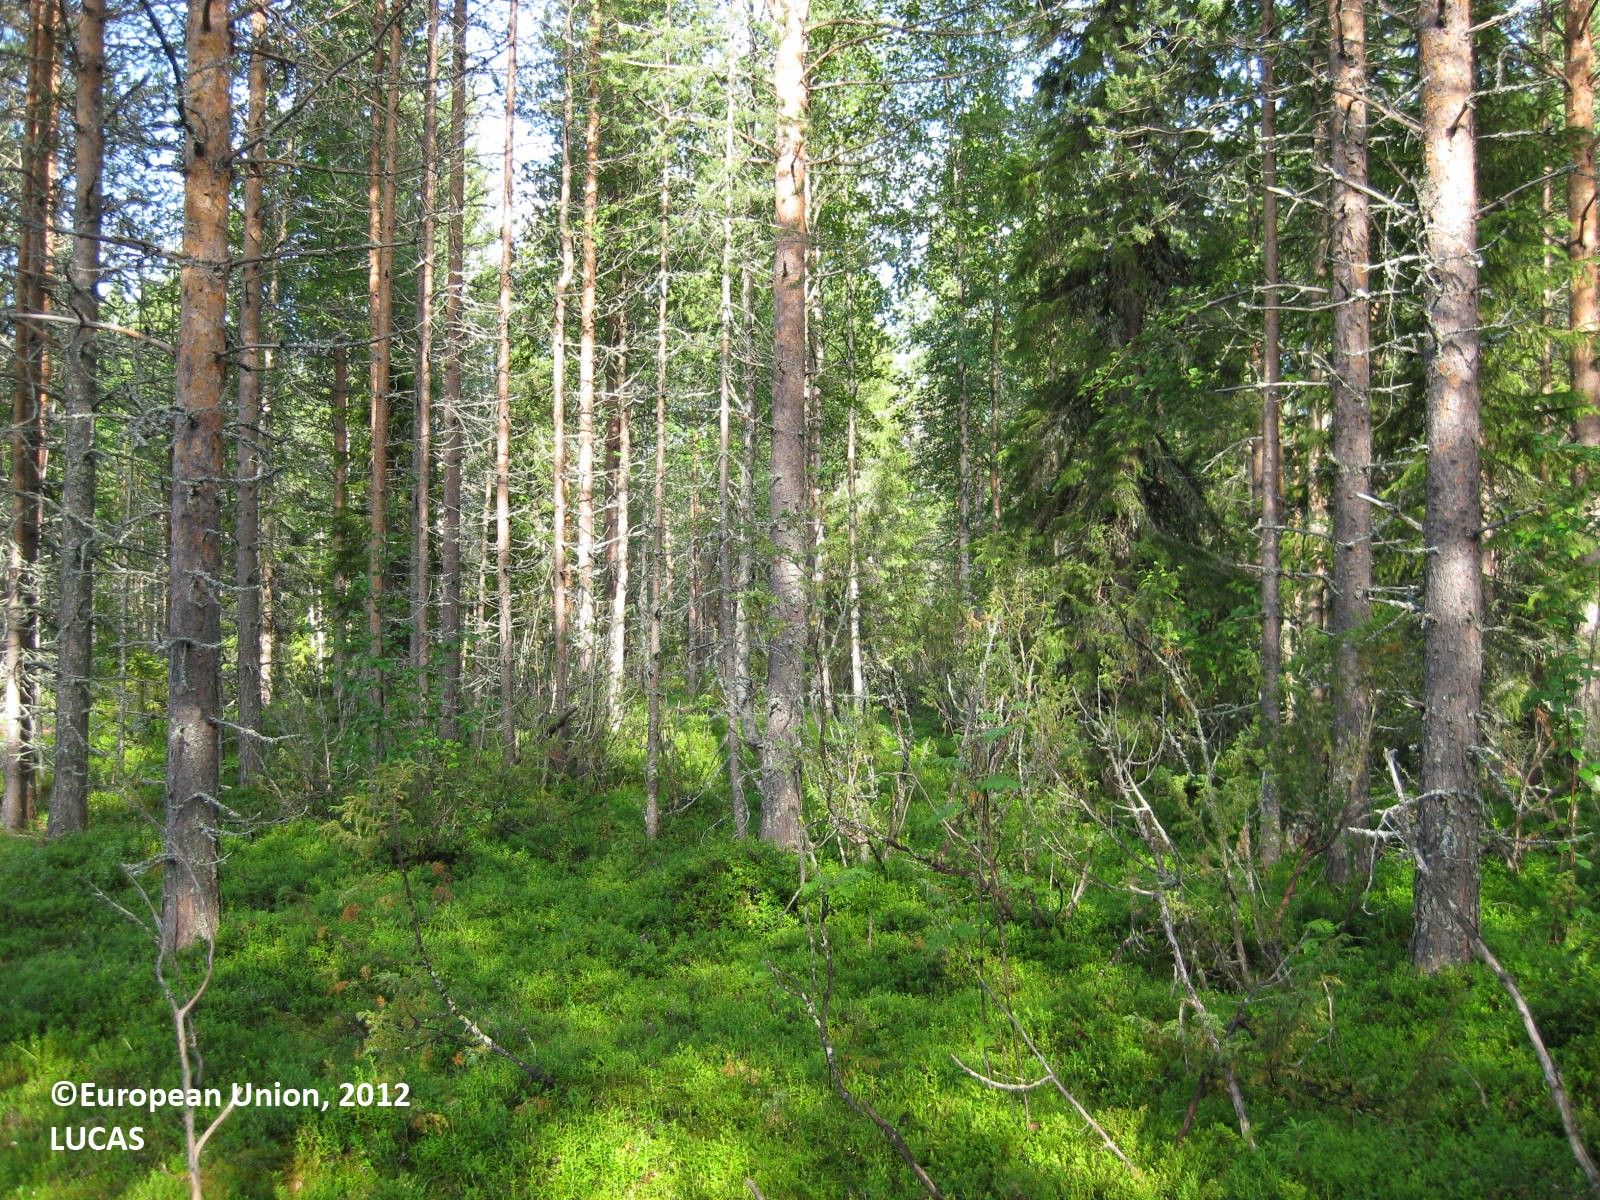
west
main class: Woodland
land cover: Pine dominated mixed woodland
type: boreal forest
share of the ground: 50 - 75 %
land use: Forestry
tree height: > 5 m
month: July
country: FI
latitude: 65.7333
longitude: 28.5870
